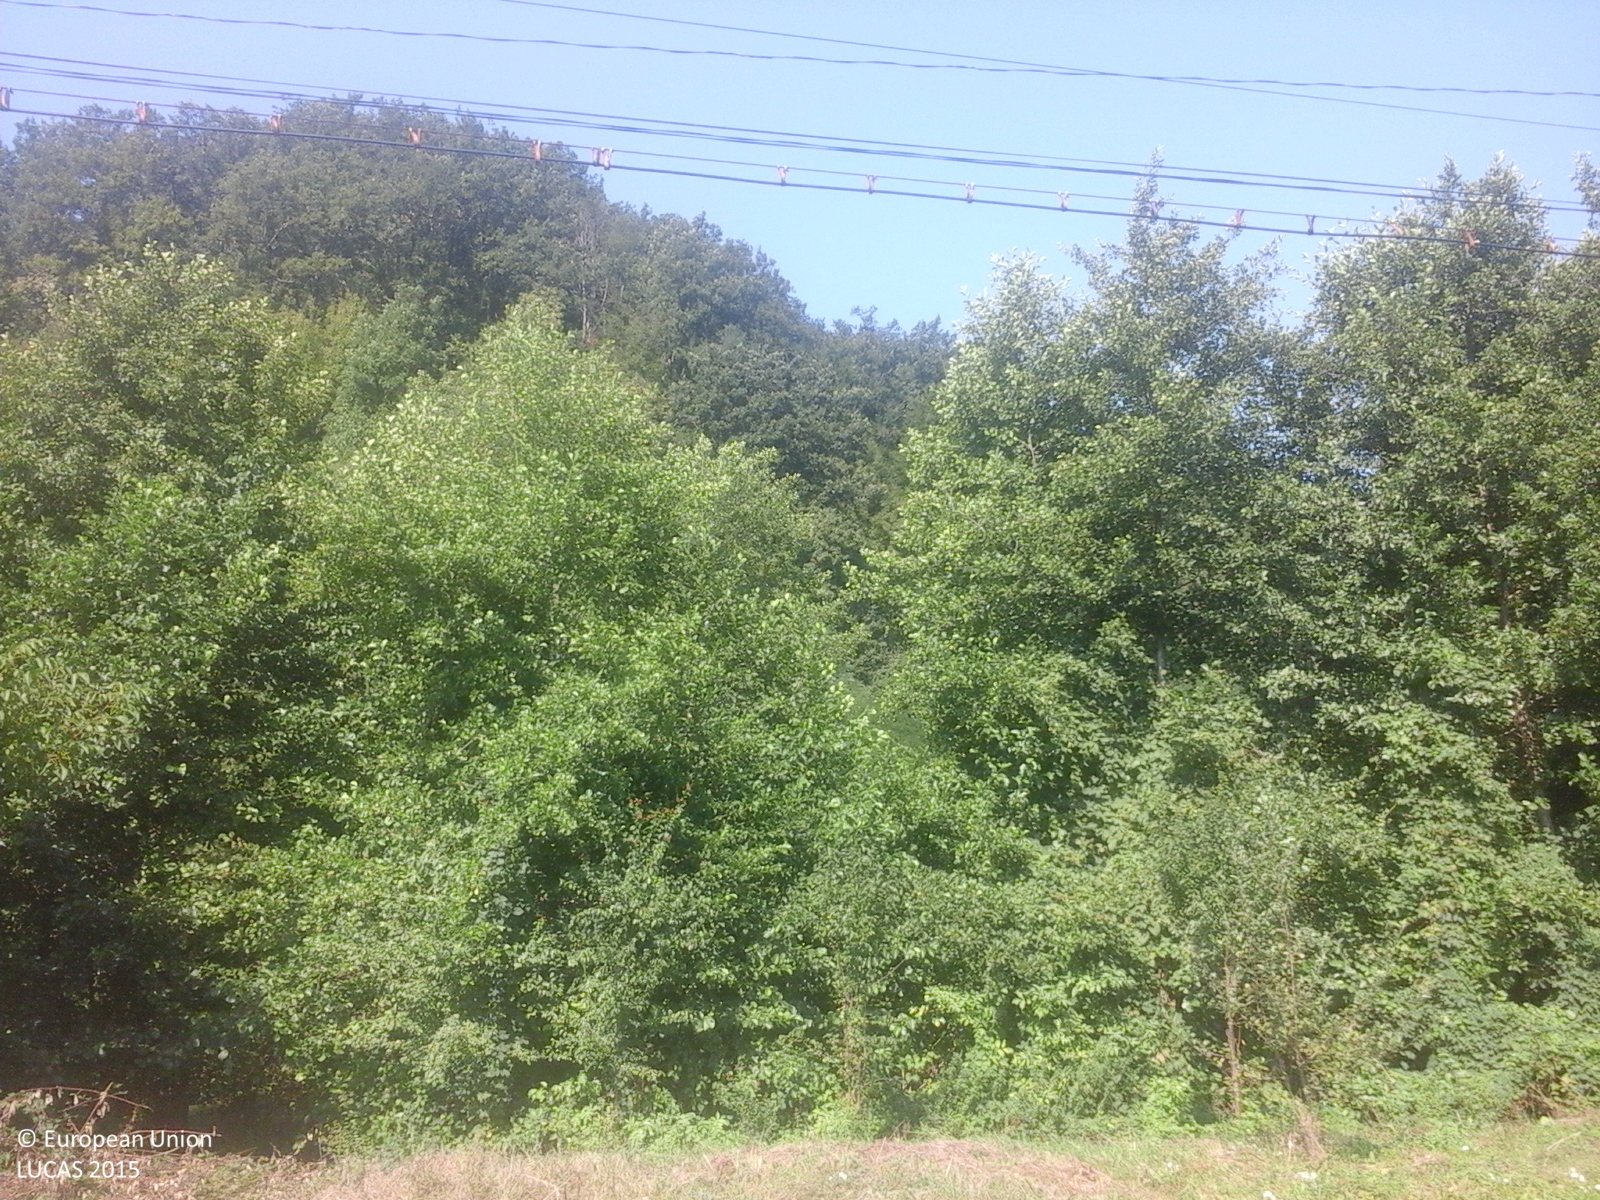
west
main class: Grassland
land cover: Grassland without tree/shrub cover
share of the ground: > 75 %
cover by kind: herbaceous plants 100 %
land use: Agriculture (excluding fallow land and kitchen gardens)
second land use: Residential
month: August
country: RO
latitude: 46.0467
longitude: 22.3889
